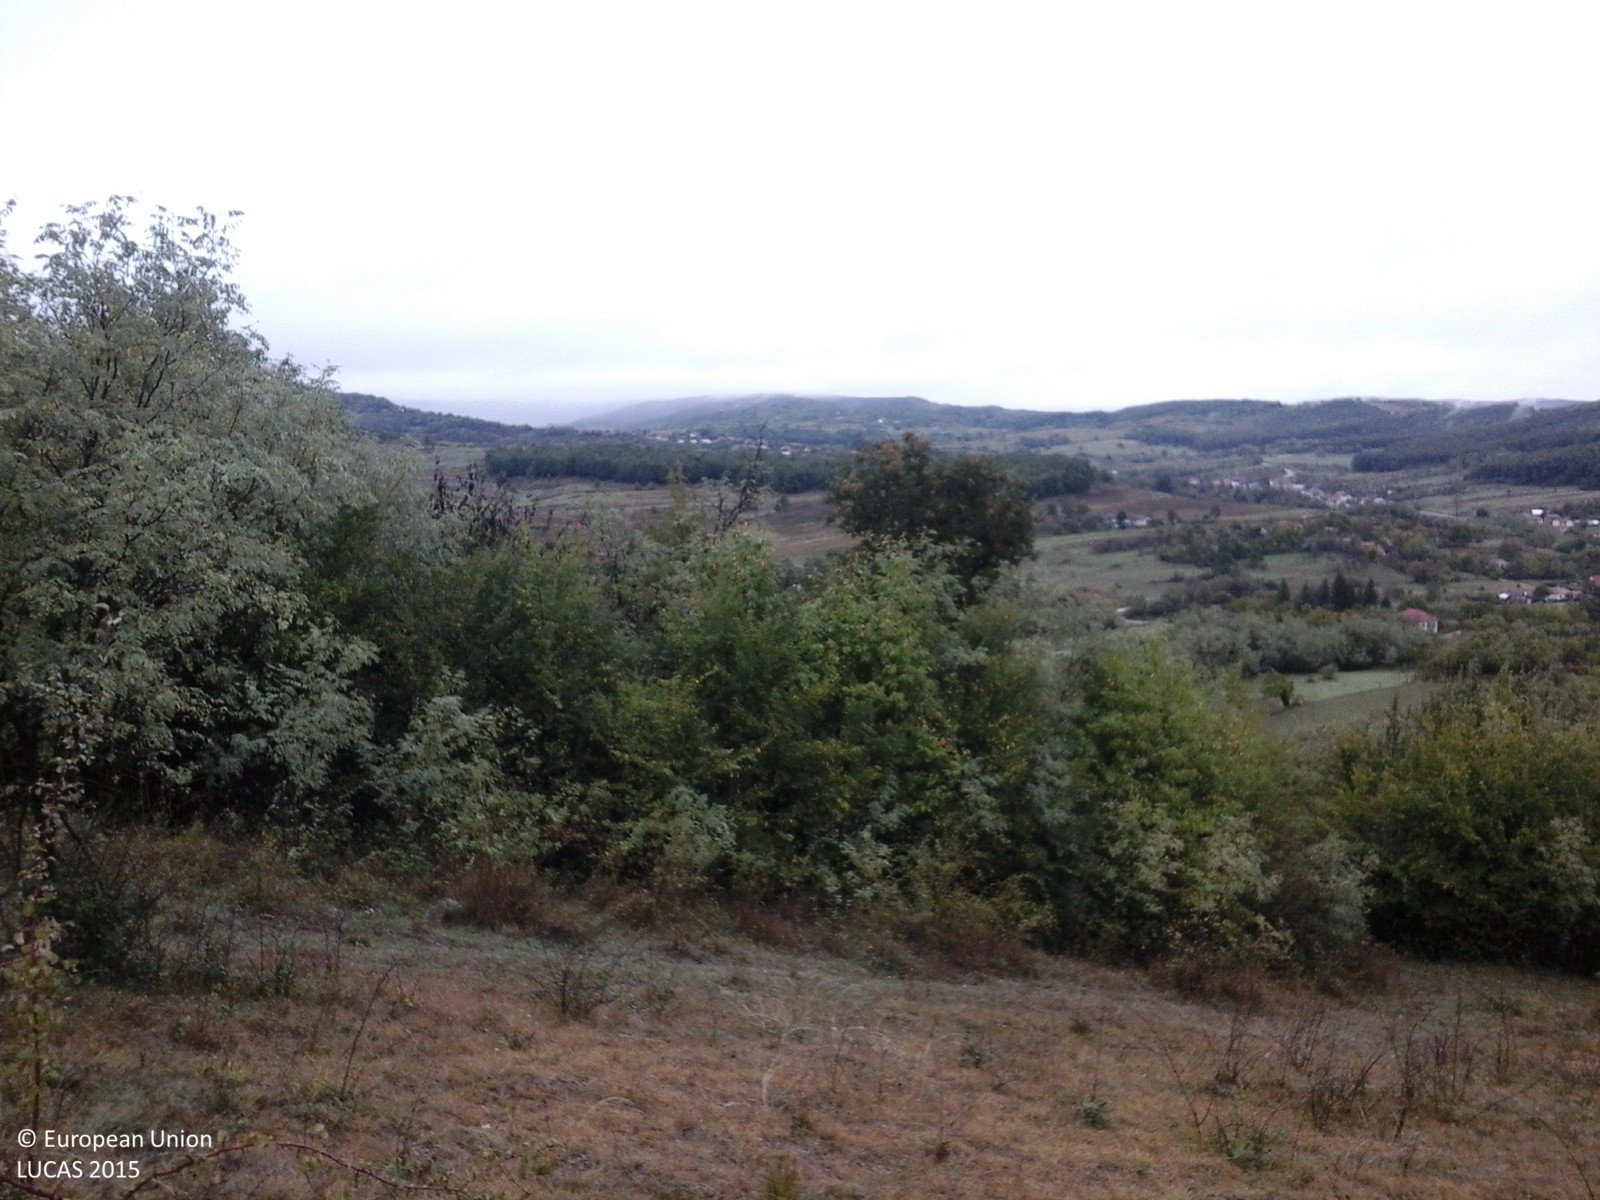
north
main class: Grassland
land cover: Grassland with sparse tree/shrub cover
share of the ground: > 75 %
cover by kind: herbaceous plants 85 %, shrubs 10 %, broadleaved forest trees 5 %
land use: Fallow land
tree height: < 5 m
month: September
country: RO
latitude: 44.9407
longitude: 23.6574
